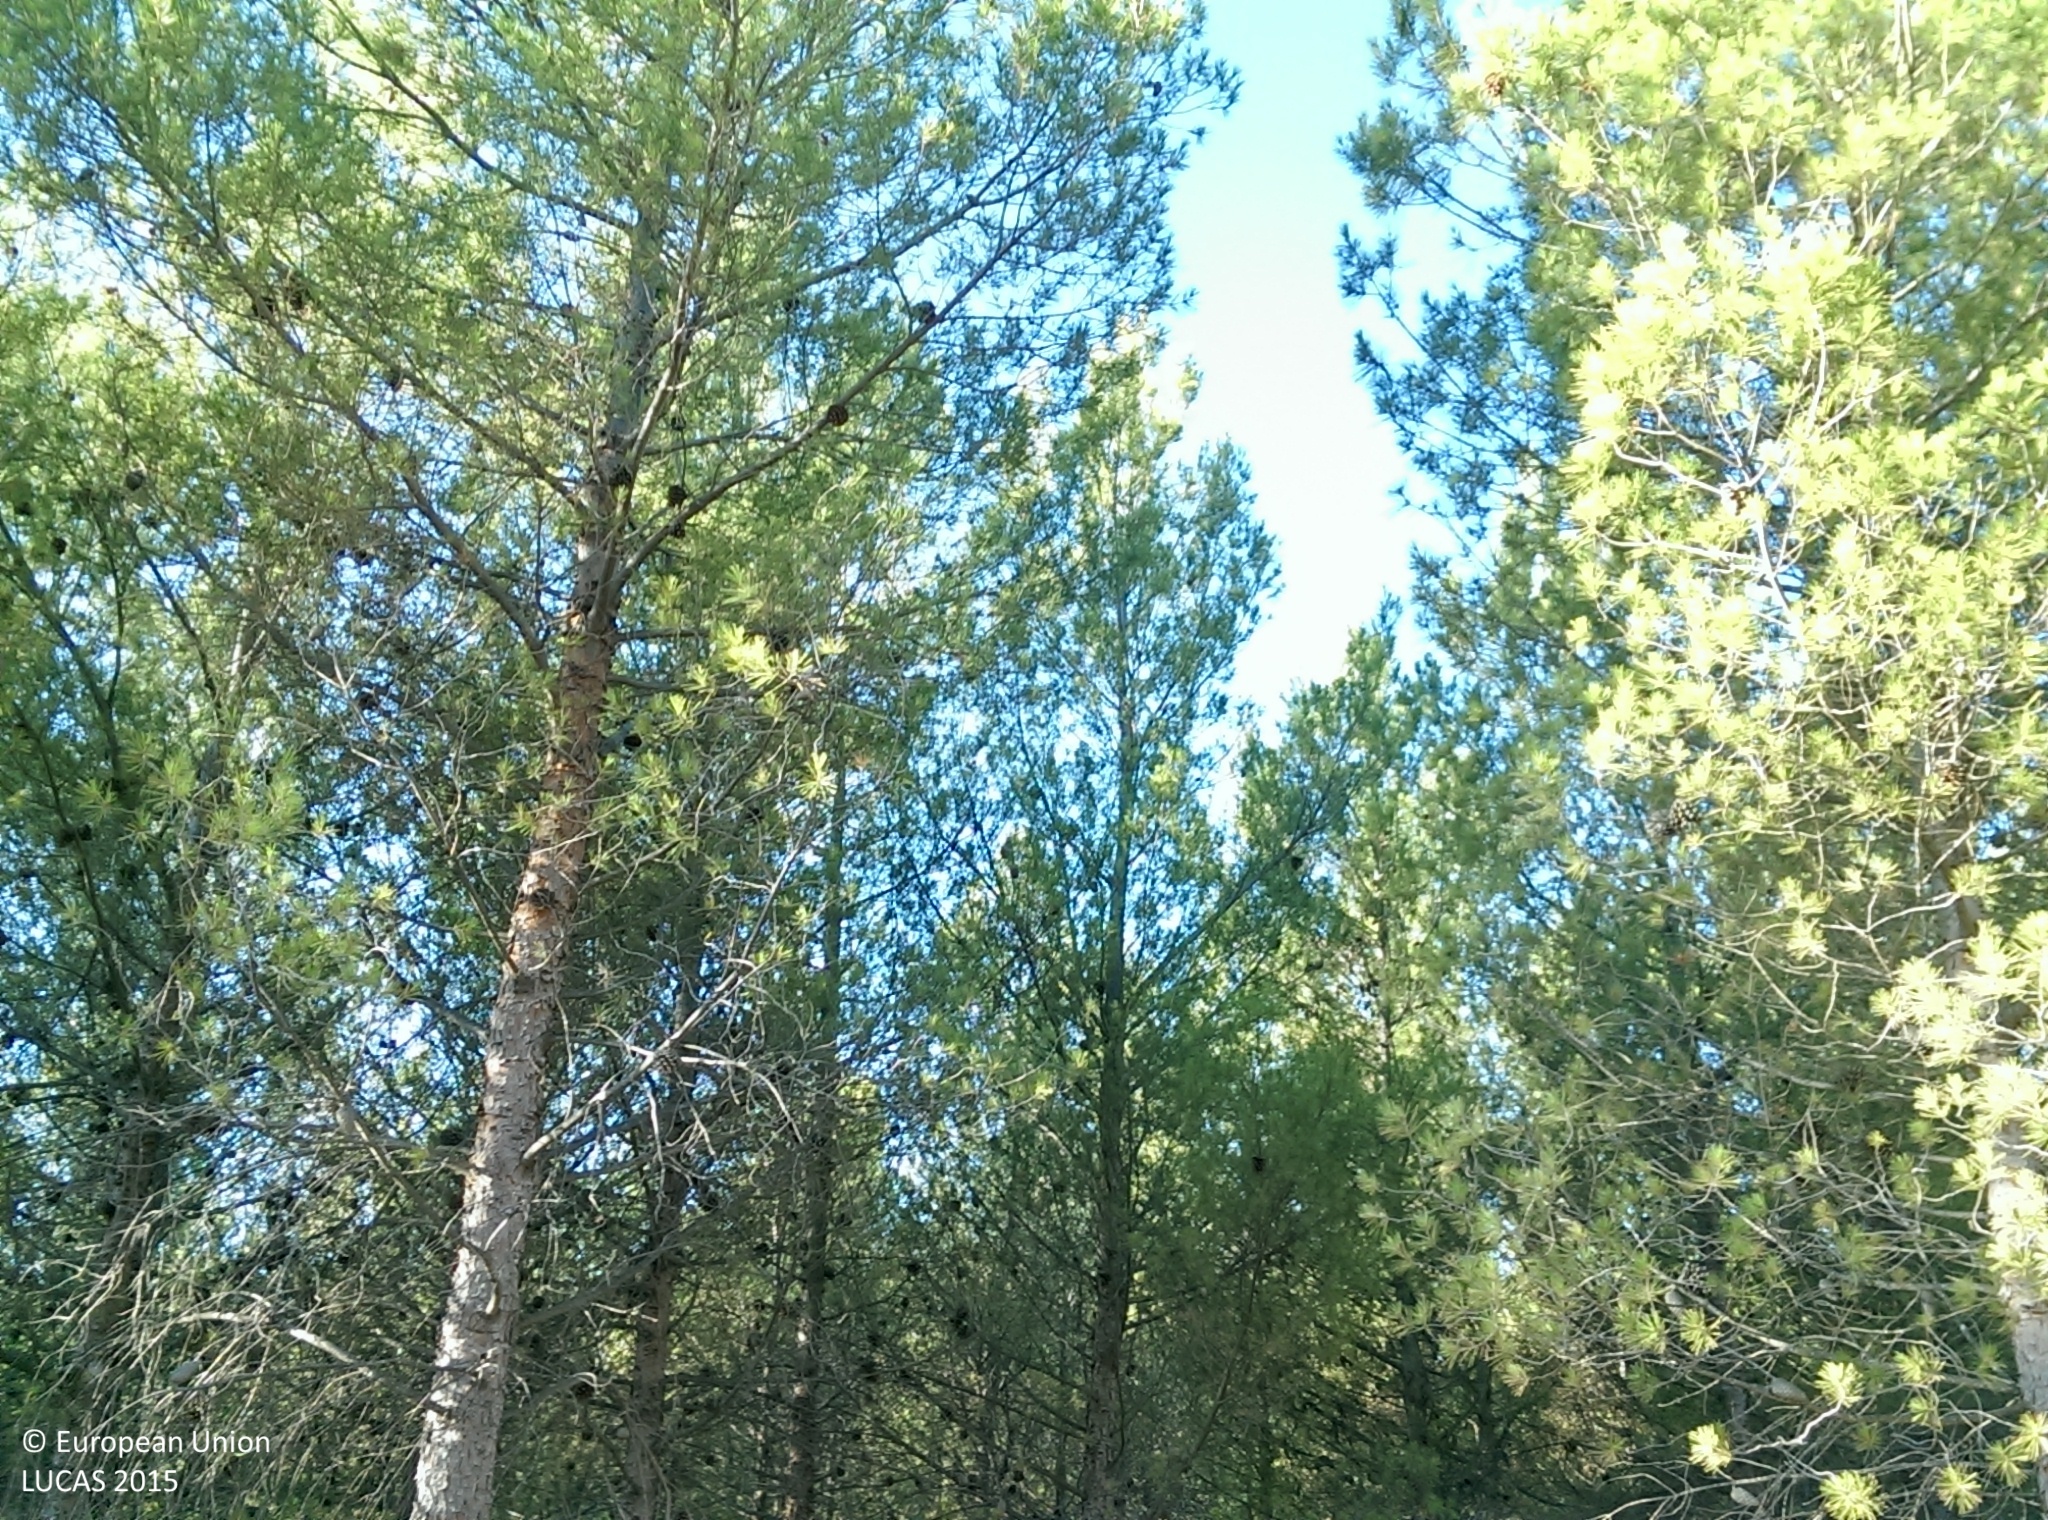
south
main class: Shrubland
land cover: Shrubland without tree cover
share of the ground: > 75 %
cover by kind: shrubs 75 %, herbaceous plants 15 %, consolidated bare surface 5 %, unconsolidated bare surface 5 %
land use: Semi-natural and natural areas not in use
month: August
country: ES
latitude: 36.9072
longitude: -3.1234
